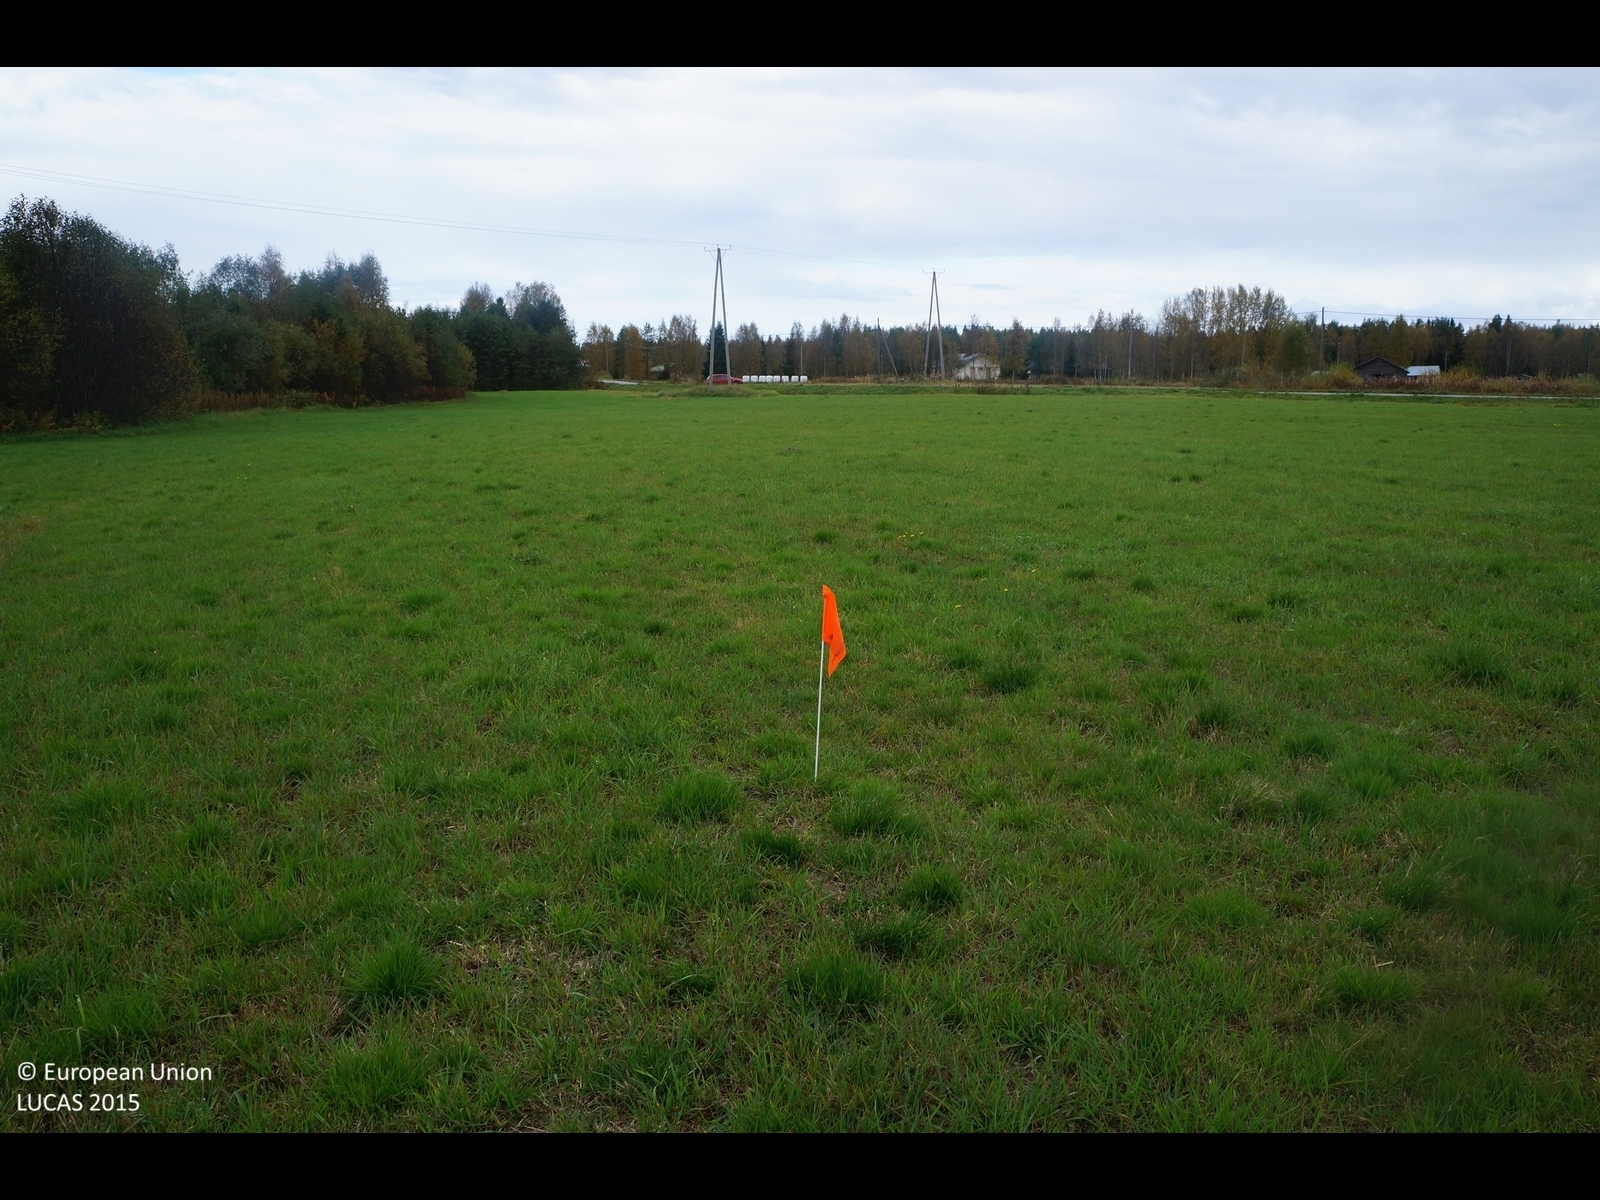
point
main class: Cropland
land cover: Temporary grasslands
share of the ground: > 75 %
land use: Agriculture (excluding fallow land and kitchen gardens)
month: September
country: FI
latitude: 64.4073
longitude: 24.3209
